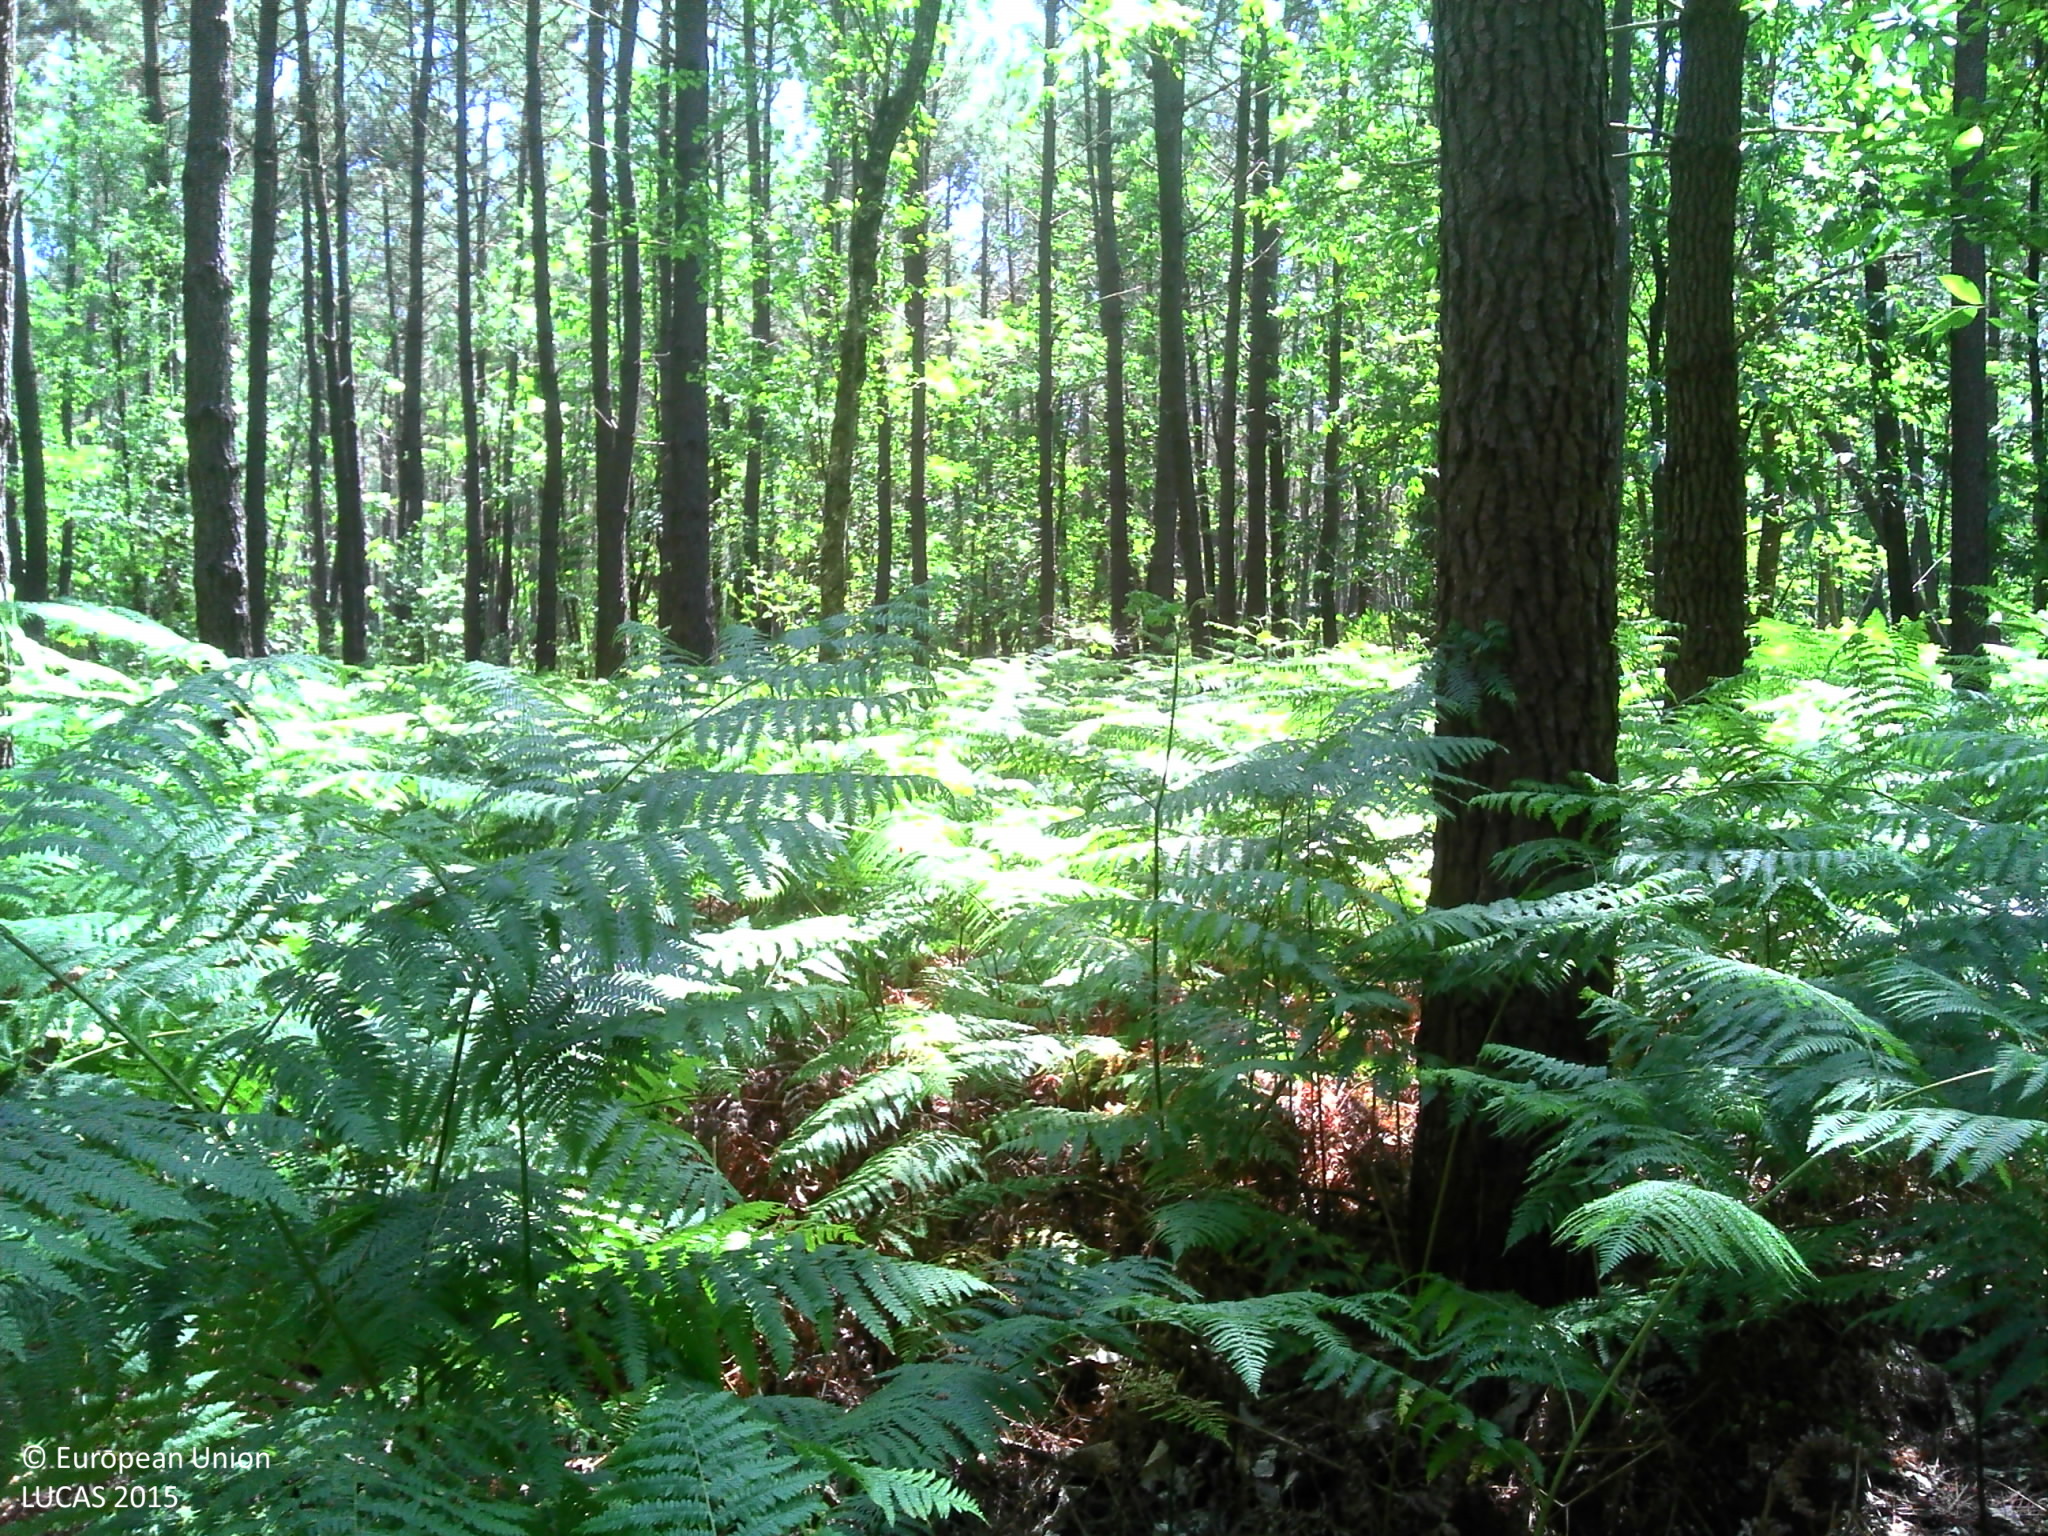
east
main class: Woodland
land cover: Pine dominated mixed woodland
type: hemiboreal forest and nemoral coniferous forest and mixed broadleaved-coniferous forest
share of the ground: > 75 %
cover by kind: coniferous forest trees 55 %, broadleaved forest trees 20 %, herbaceous plants 15 %, lichens and mosses 10 %
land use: Forestry
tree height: > 5 m
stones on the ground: < 10 %
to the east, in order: Pine dominated mixed woodland
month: June
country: FR
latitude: 47.3740
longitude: 0.0556
